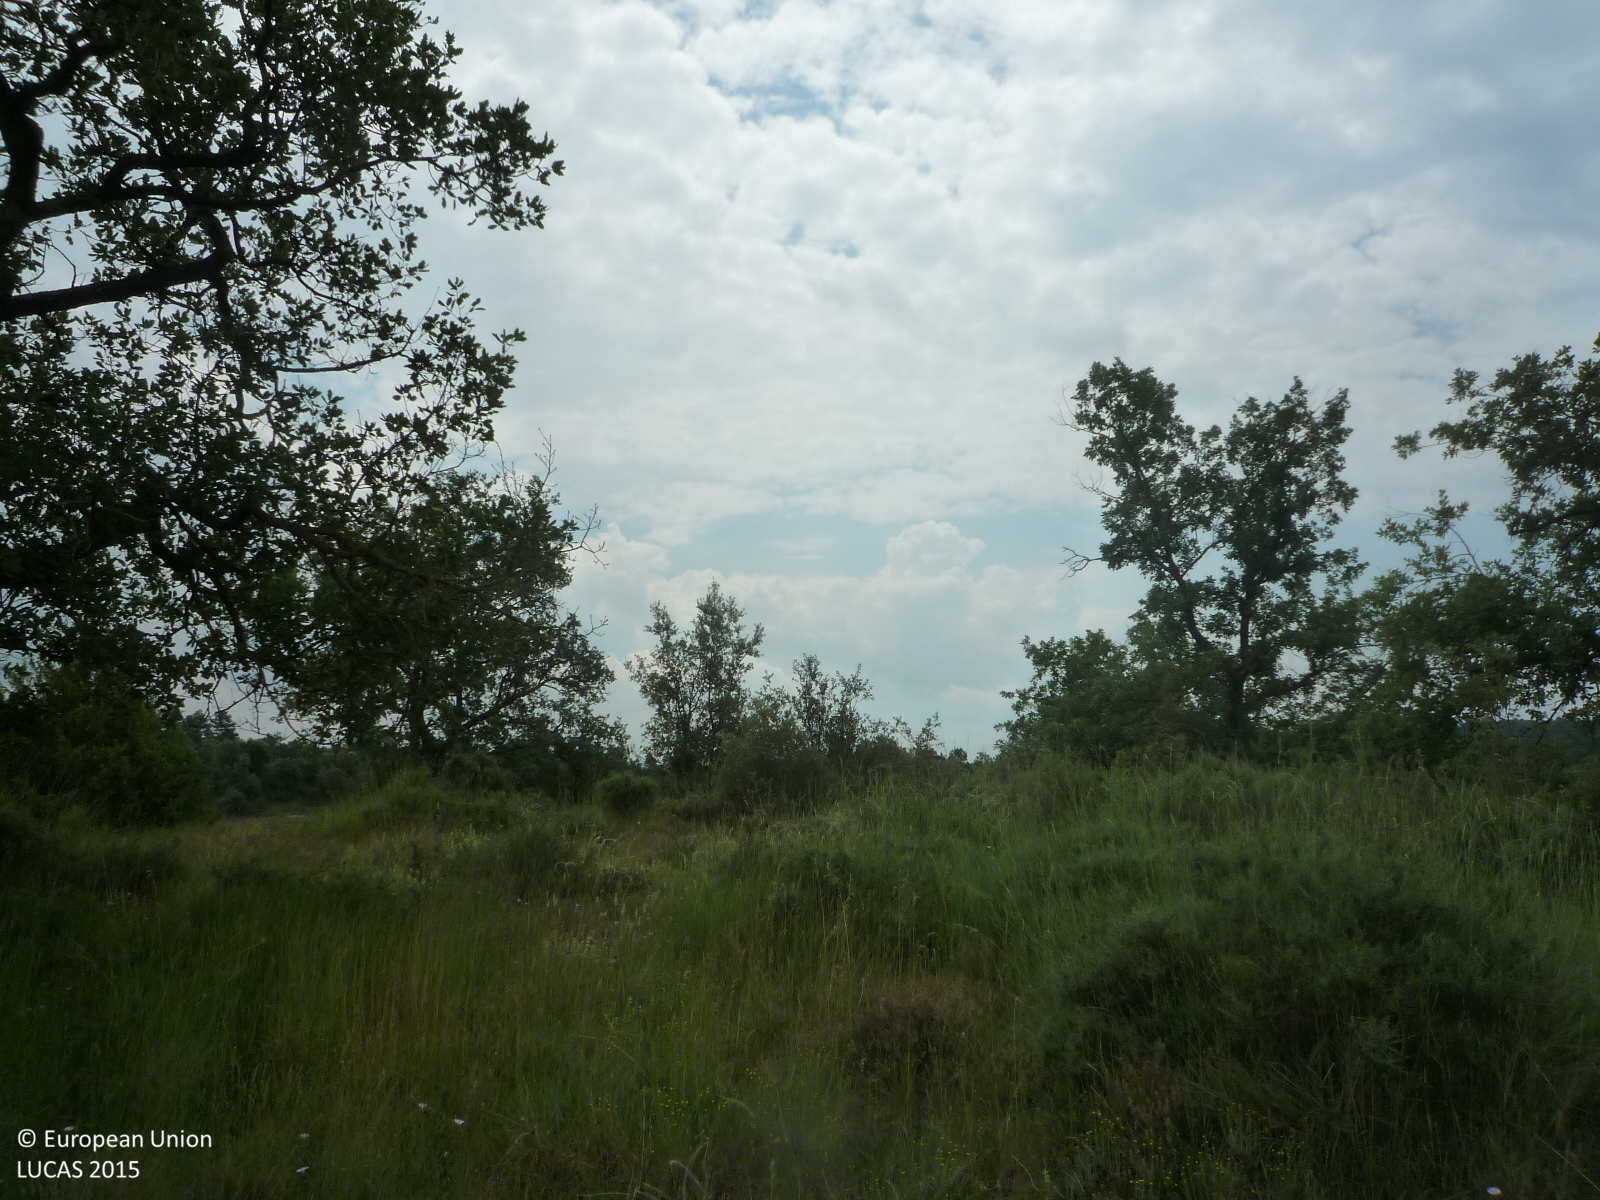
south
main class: Grassland
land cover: Grassland with sparse tree/shrub cover
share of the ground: > 75 %
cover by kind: herbaceous plants 95 %, broadleaved forest trees 5 %
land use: Agriculture (excluding fallow land and kitchen gardens)
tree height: < 5 m
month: June
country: ES
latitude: 41.9933
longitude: 2.0106
